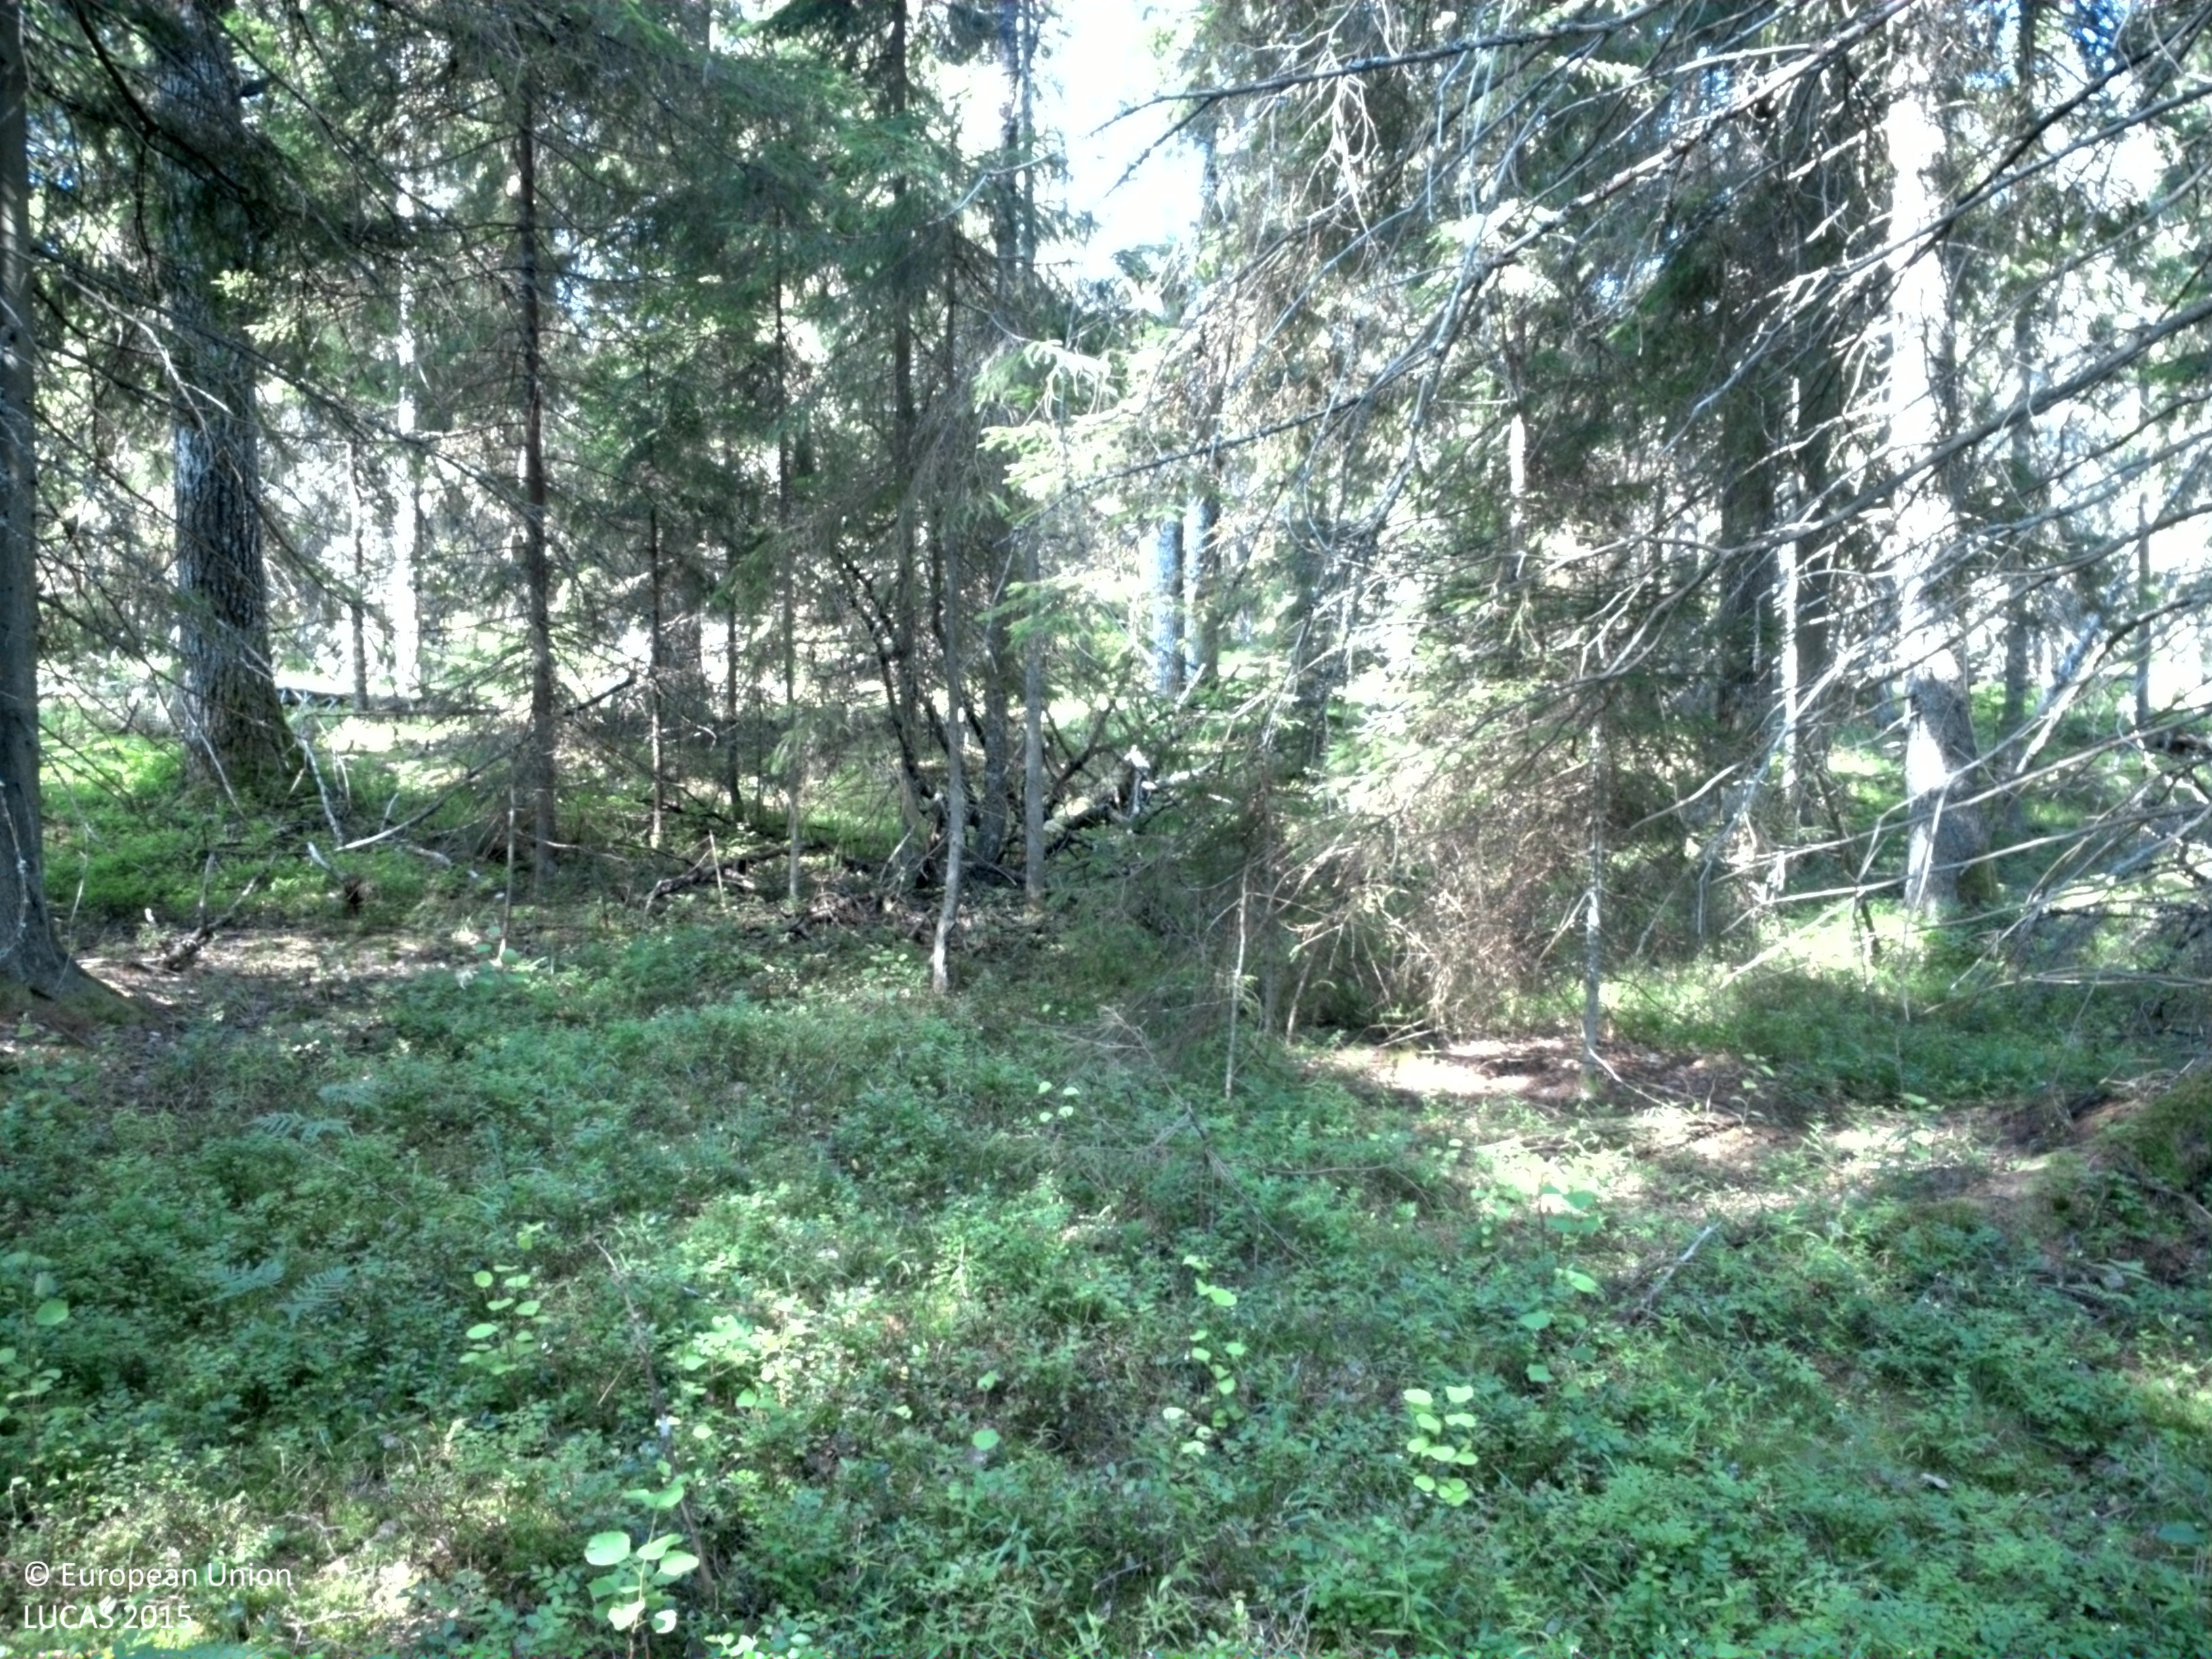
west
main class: Woodland
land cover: Spruce dominated coniferous woodland
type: boreal forest
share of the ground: 50 - 75 %
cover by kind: coniferous forest trees 60 %, lichens and mosses 25 %, herbaceous plants 10 %, broadleaved forest trees 5 %
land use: Amenities, museums, leisure
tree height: > 5 m
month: July
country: SE
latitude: 59.6457
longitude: 18.6043
